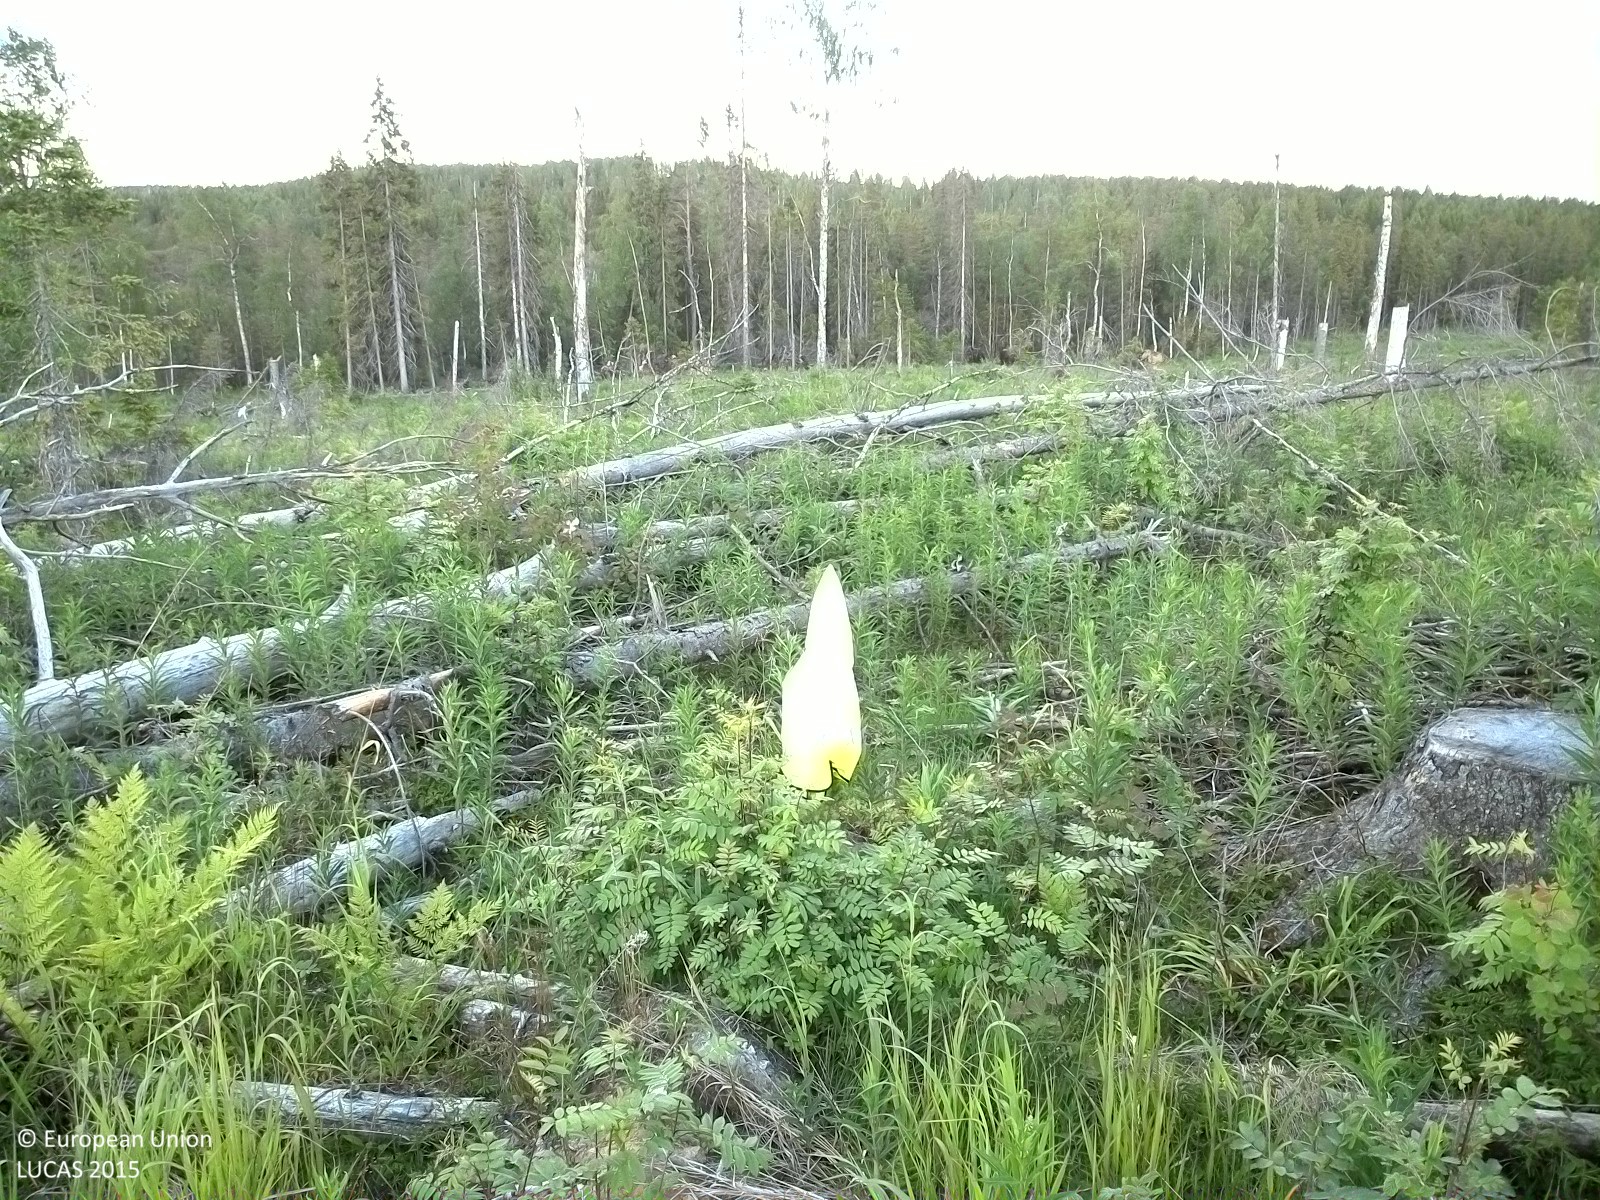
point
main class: Woodland
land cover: Broadleaved woodland
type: boreal forest
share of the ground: 10 - 25 %
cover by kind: herbaceous plants 65 %, unconsolidated bare surface 20 %, broadleaved forest trees 15 %
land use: Forestry
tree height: < 5 m
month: July
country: SE
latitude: 62.1889
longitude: 16.7630
